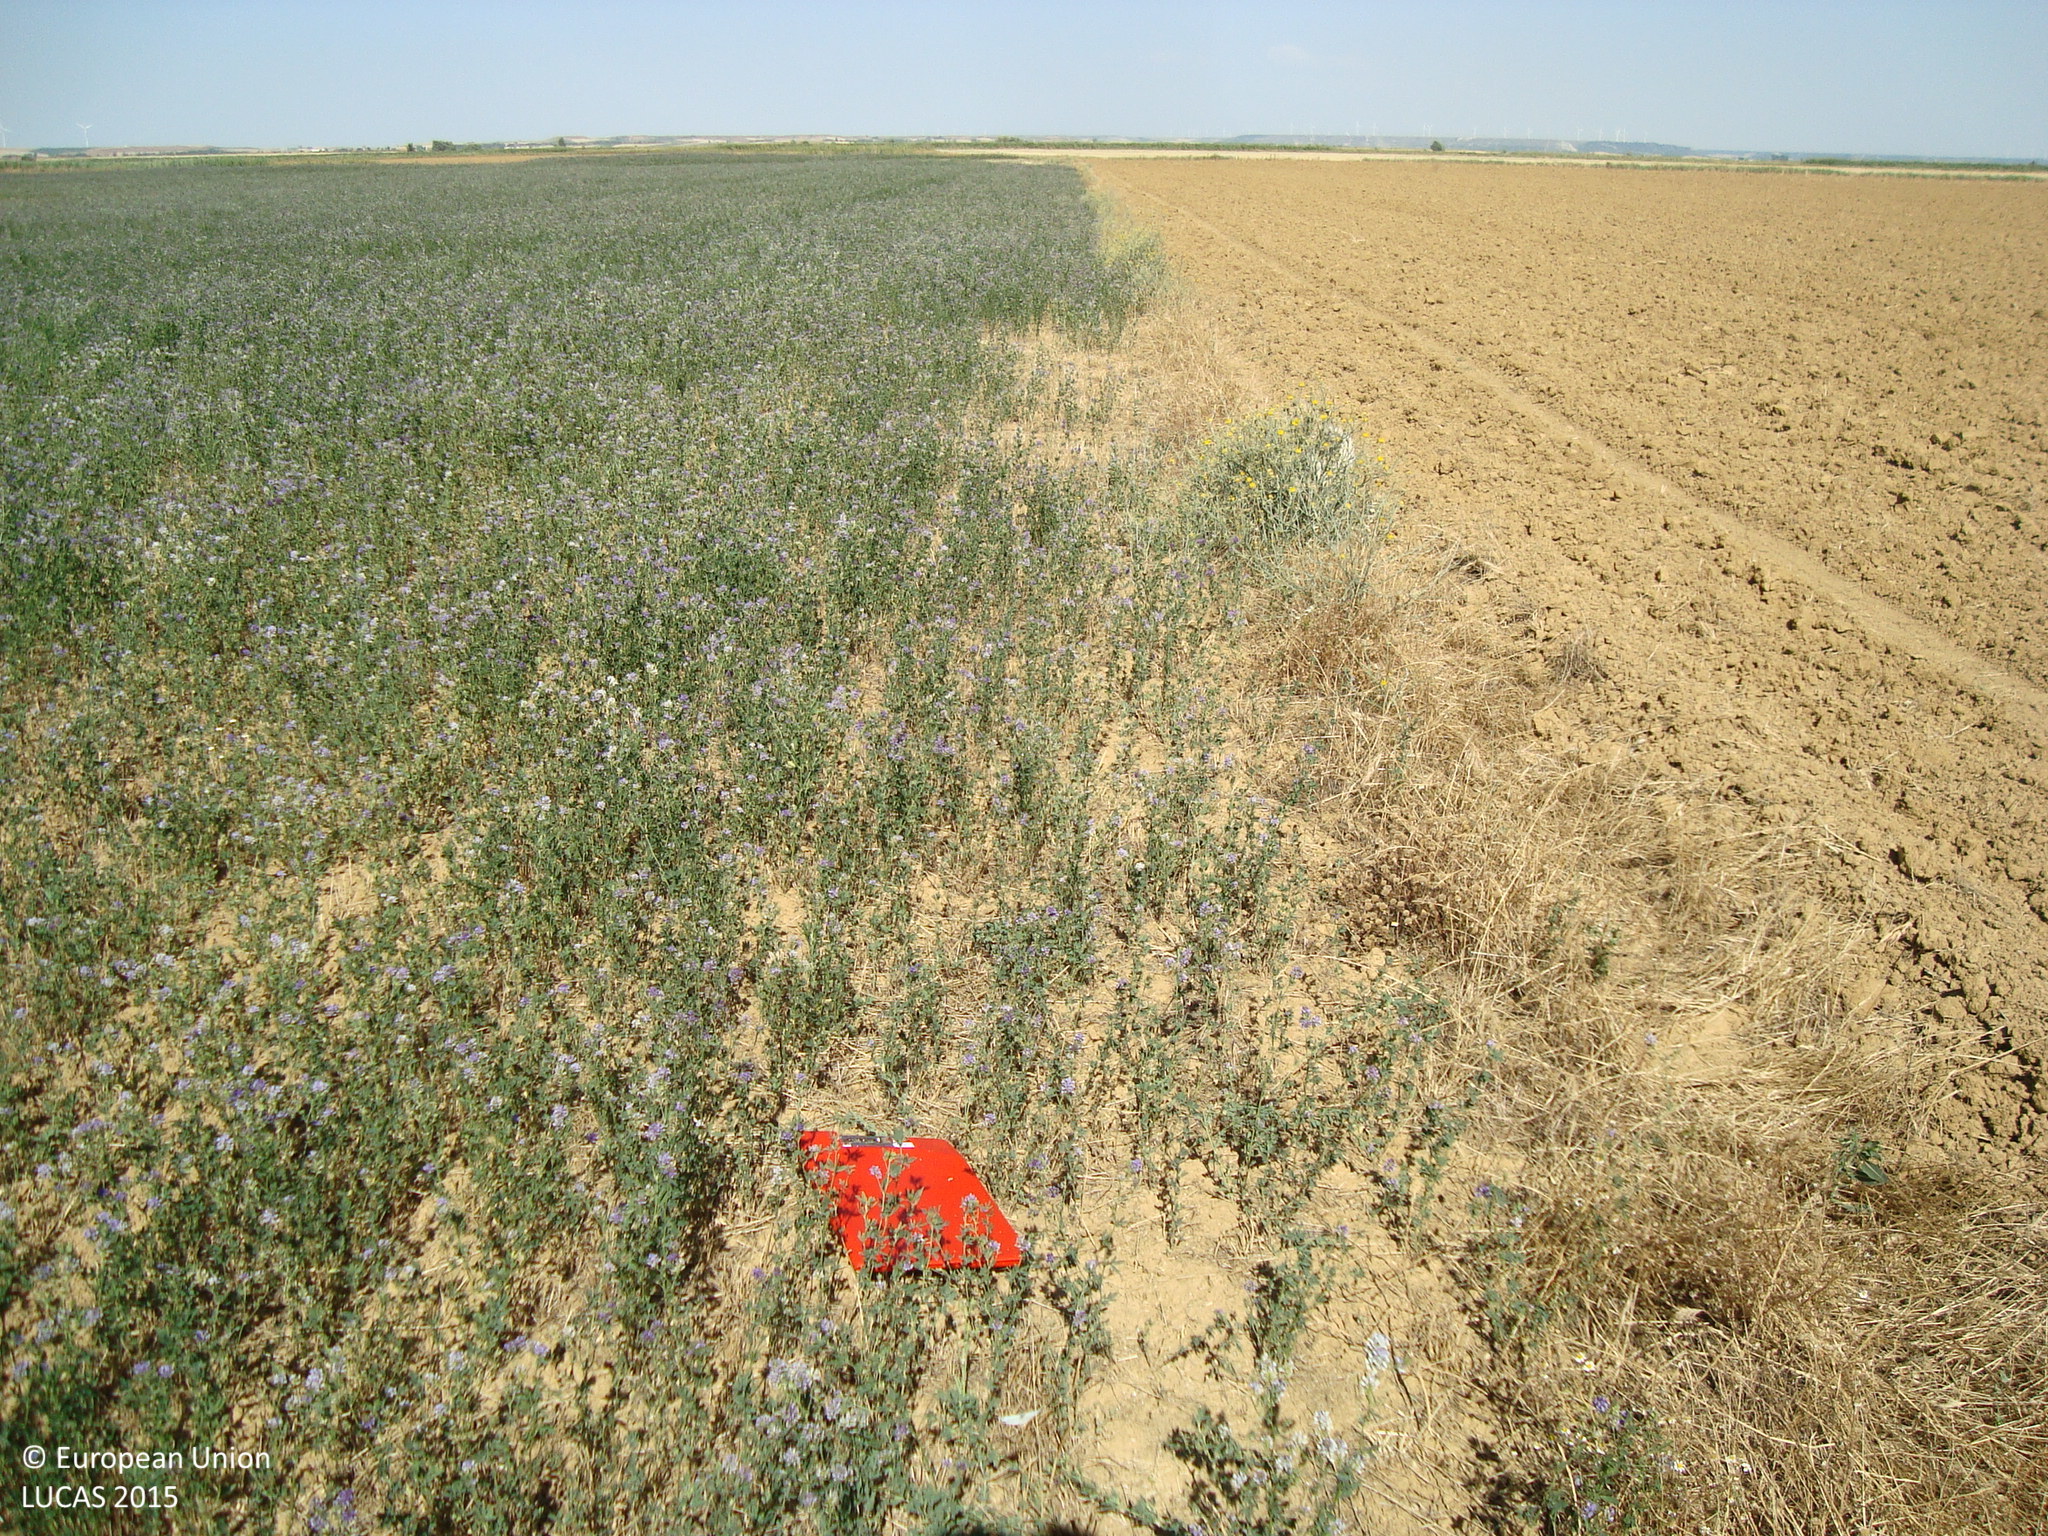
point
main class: Cropland
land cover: Lucerne
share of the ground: > 75 %
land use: Agriculture (excluding fallow land and kitchen gardens)
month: July
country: ES
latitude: 42.0823
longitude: -4.7379
